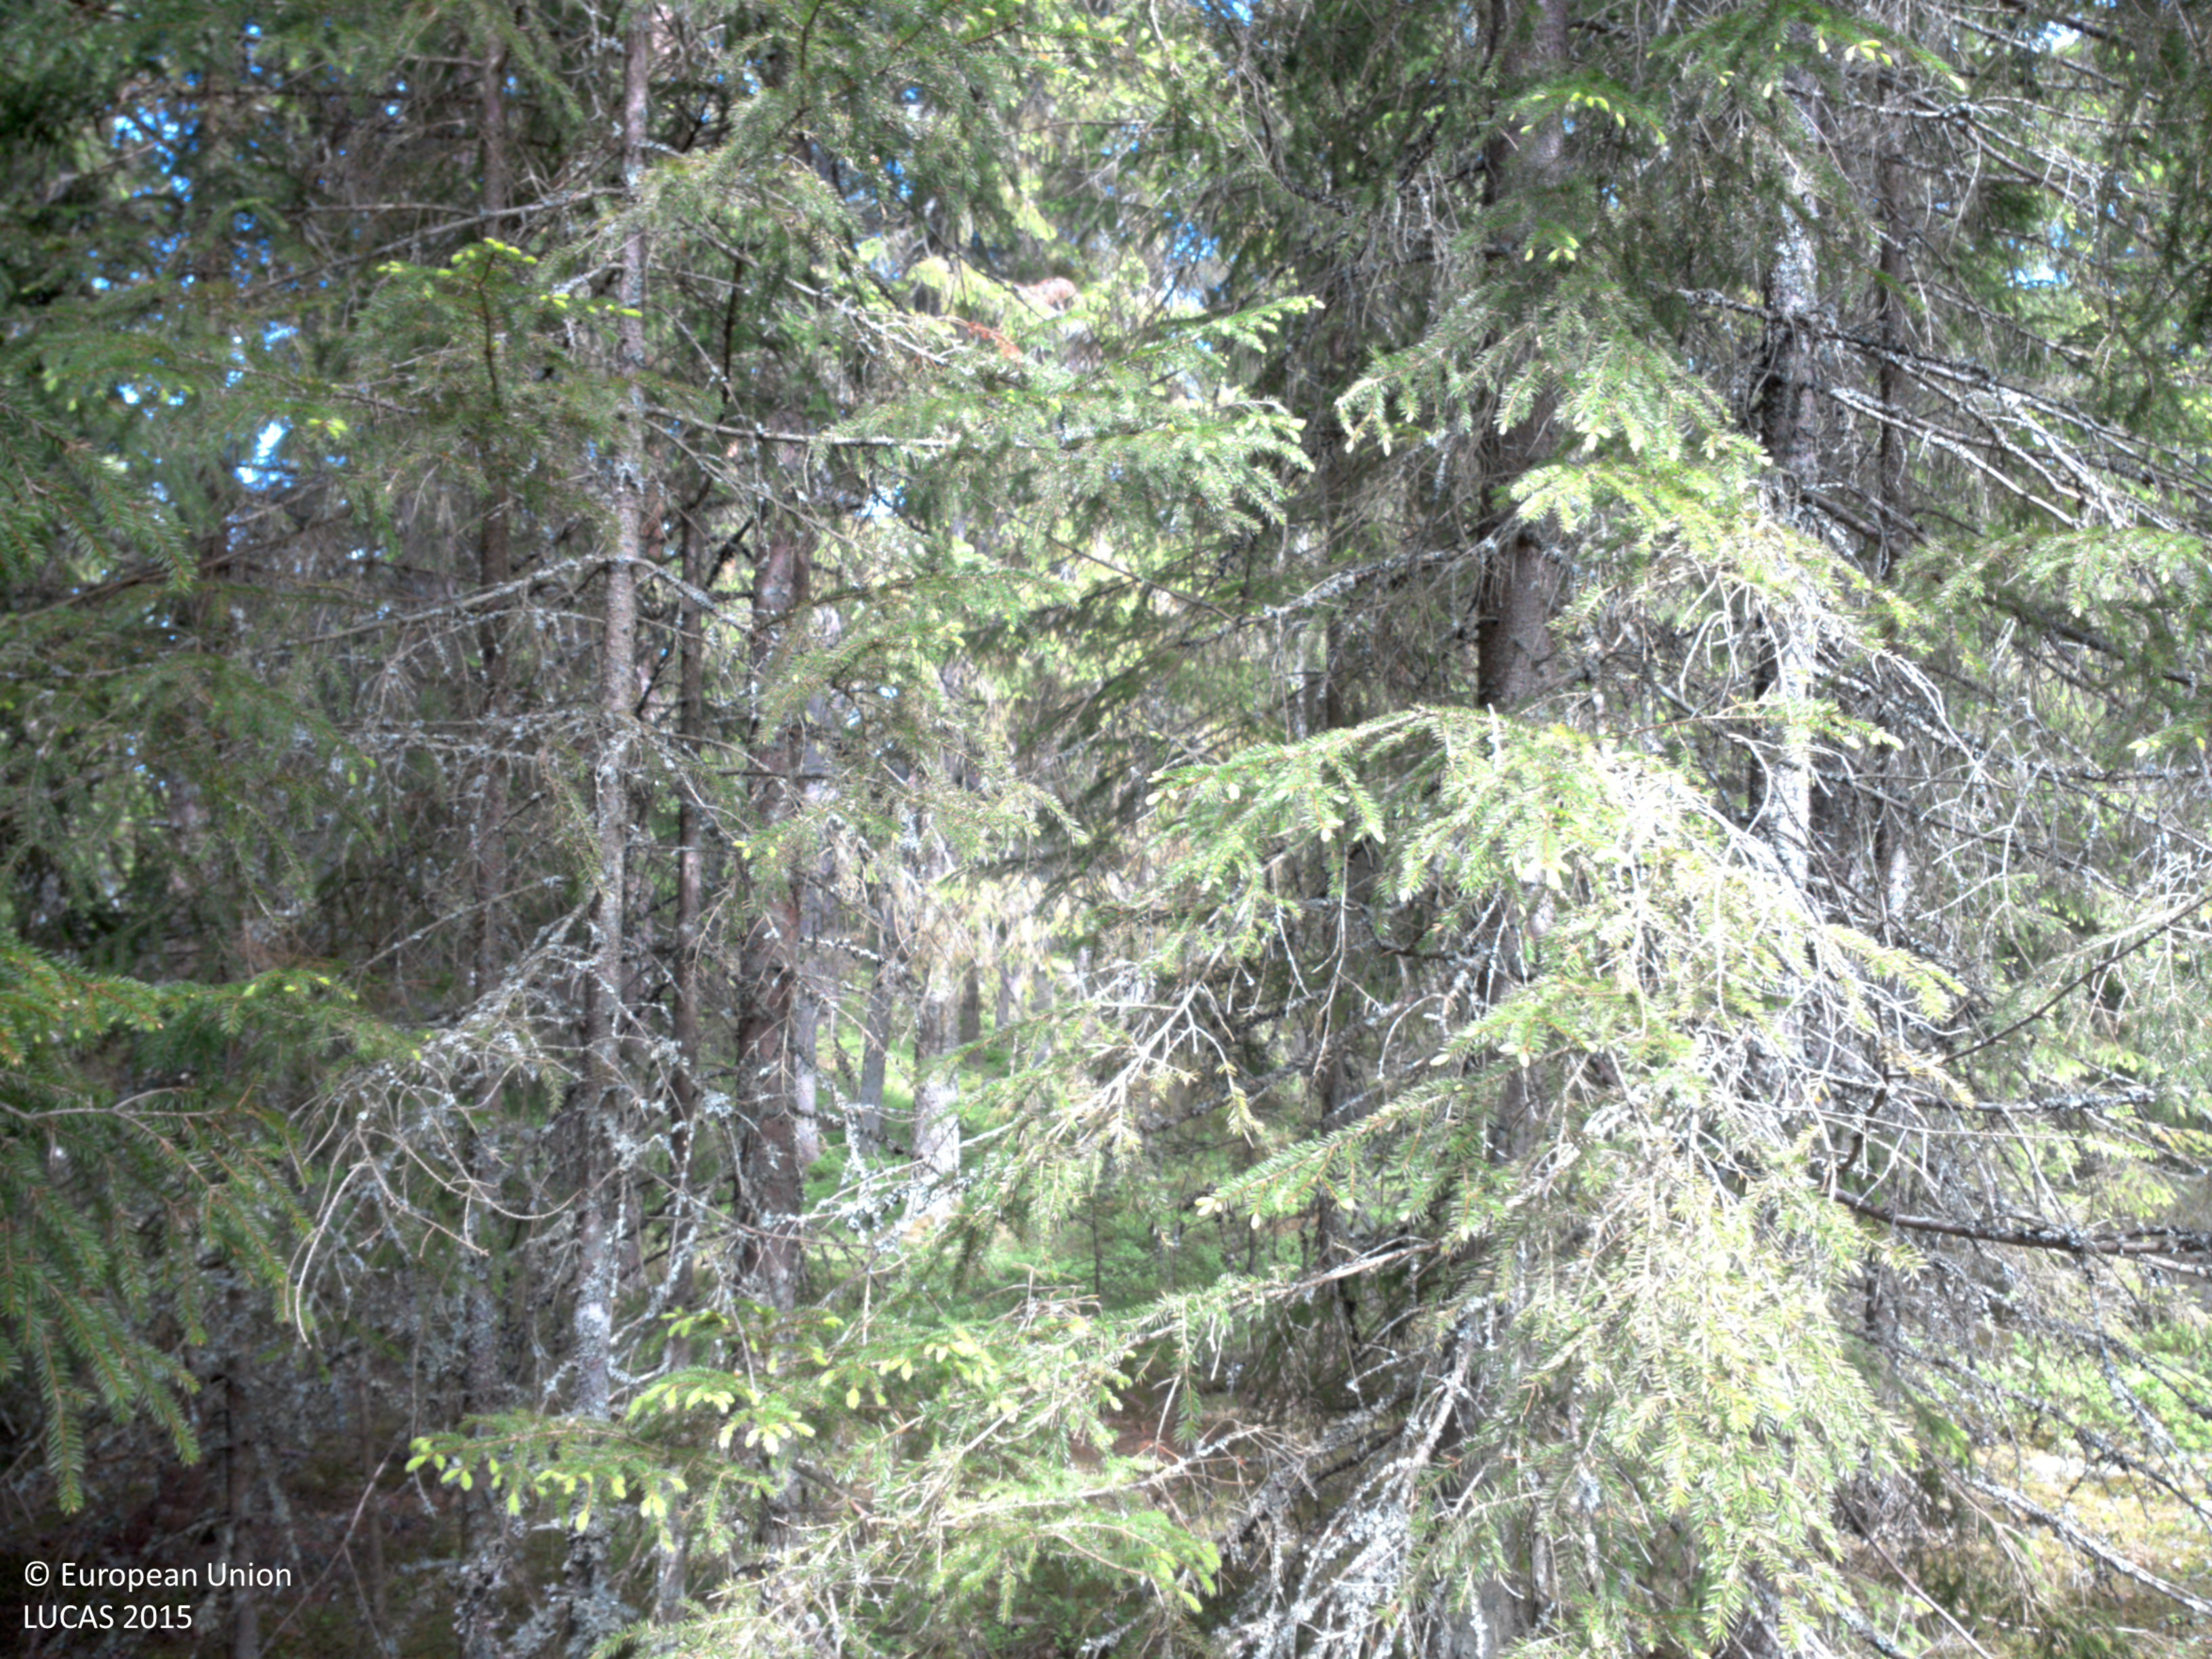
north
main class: Woodland
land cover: Spruce dominated coniferous woodland
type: boreal forest
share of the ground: 50 - 75 %
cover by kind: coniferous forest trees 55 %, lichens and mosses 30 %, herbaceous plants 10 %, shrubs 5 %
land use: Forestry
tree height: > 5 m
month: June
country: SE
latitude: 59.1707
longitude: 12.3561
